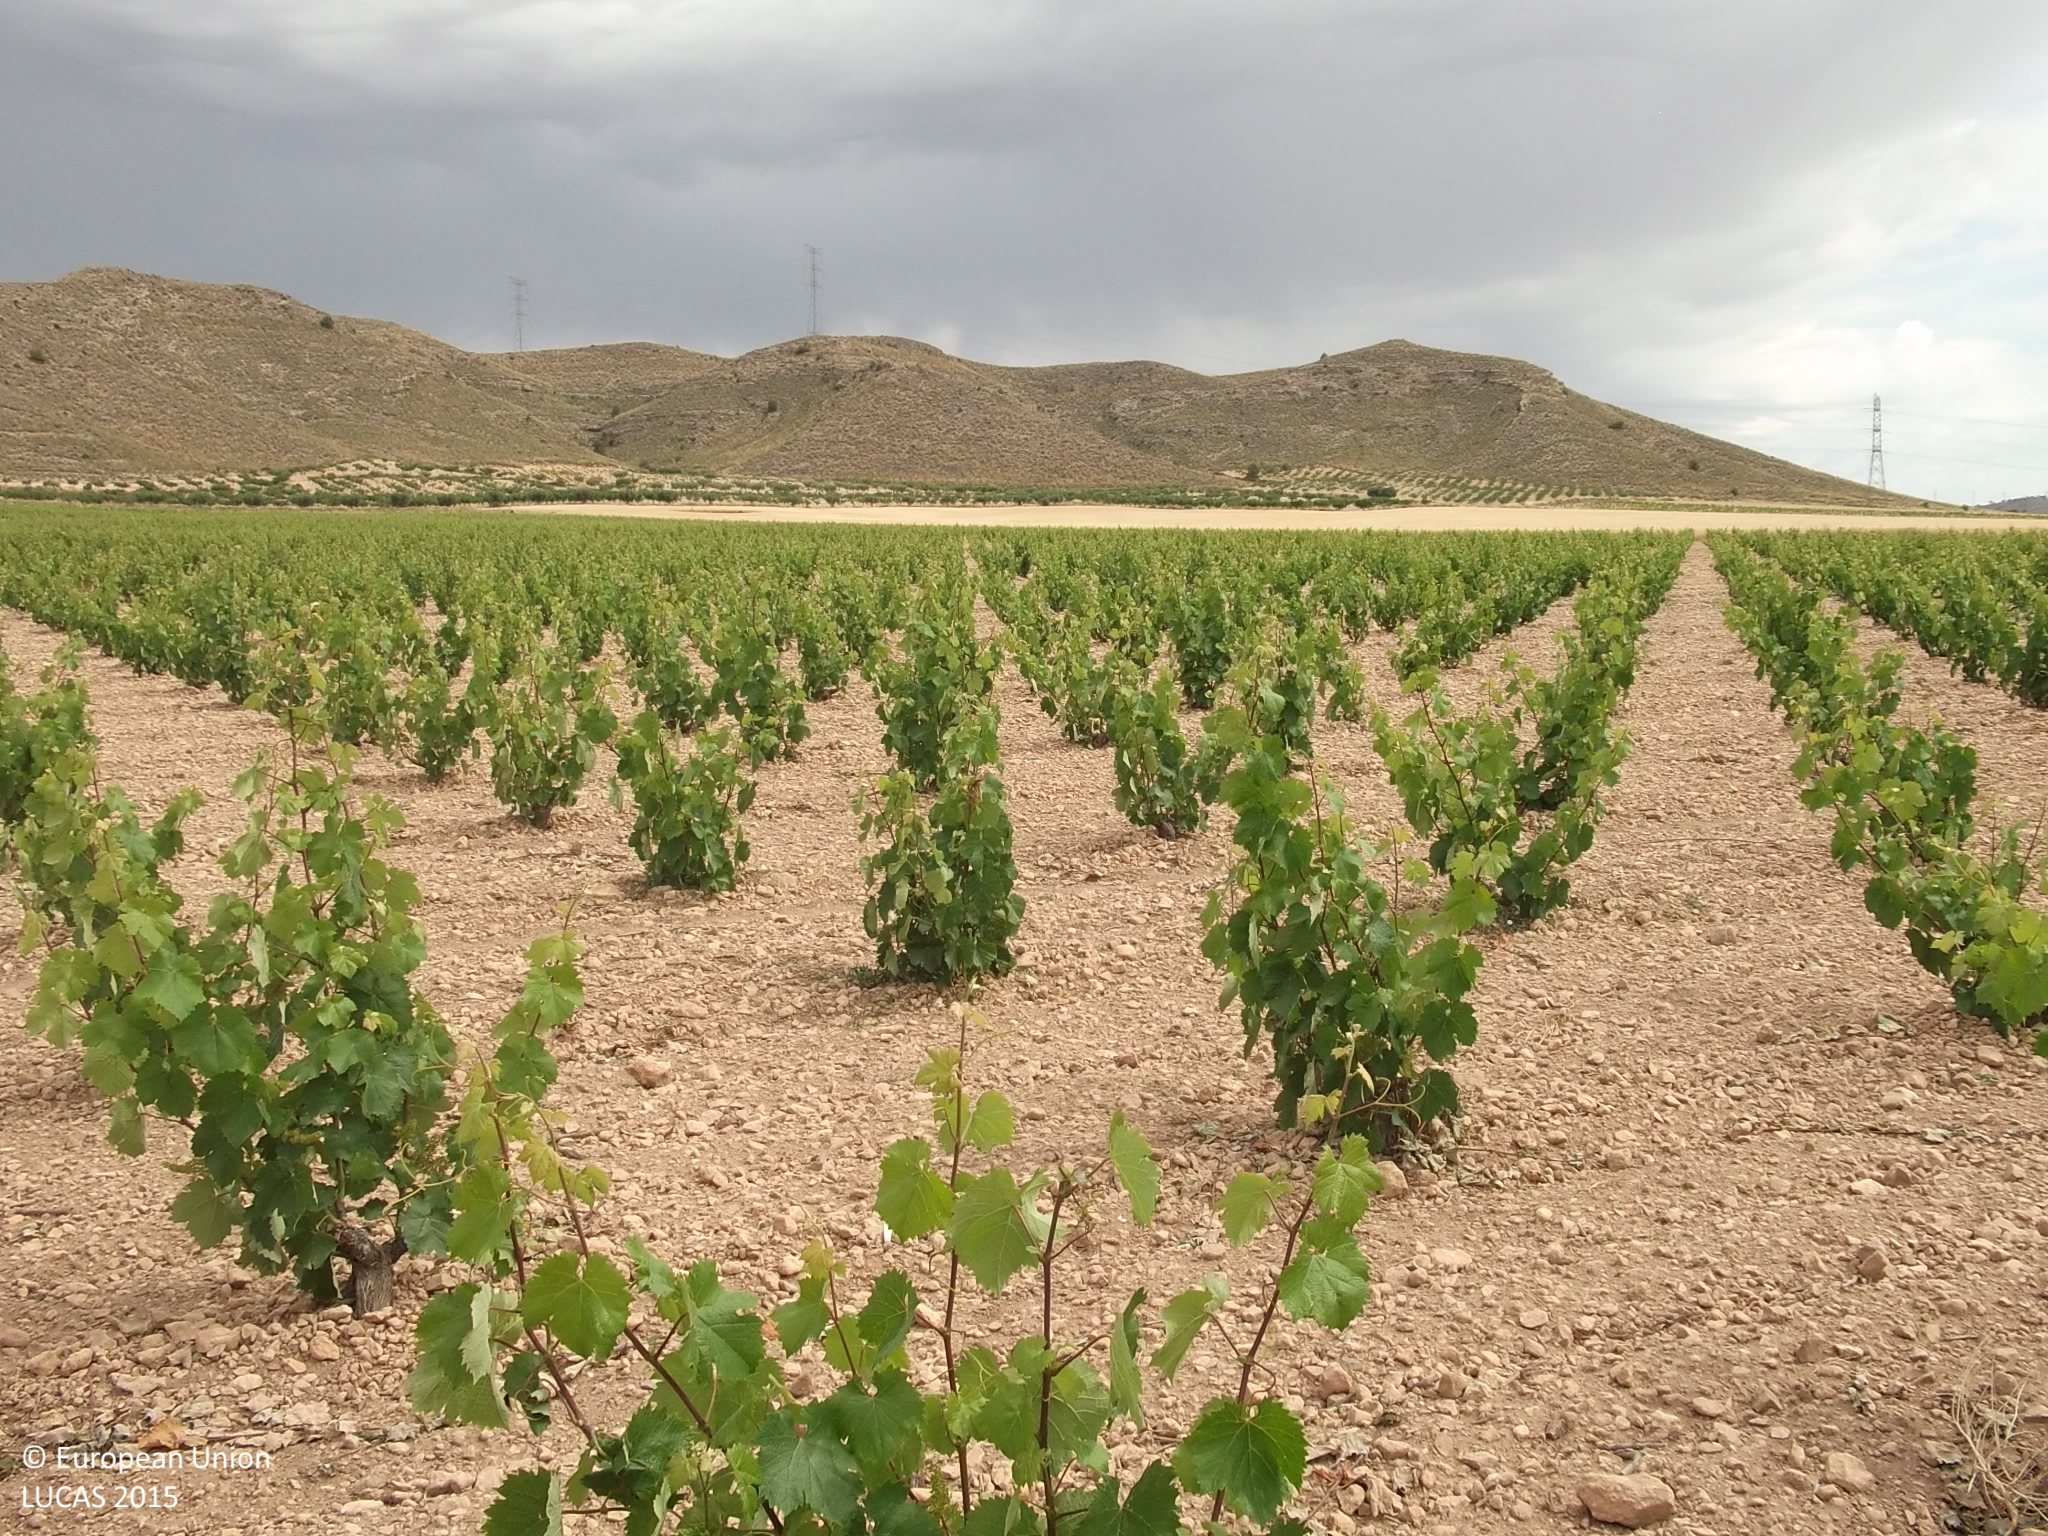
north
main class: Cropland
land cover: Vineyards
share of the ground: 10 - 25 %
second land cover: Other bare soil
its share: > 75 %
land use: Agriculture (excluding fallow land and kitchen gardens)
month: May
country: ES
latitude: 38.5277
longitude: -1.3591
